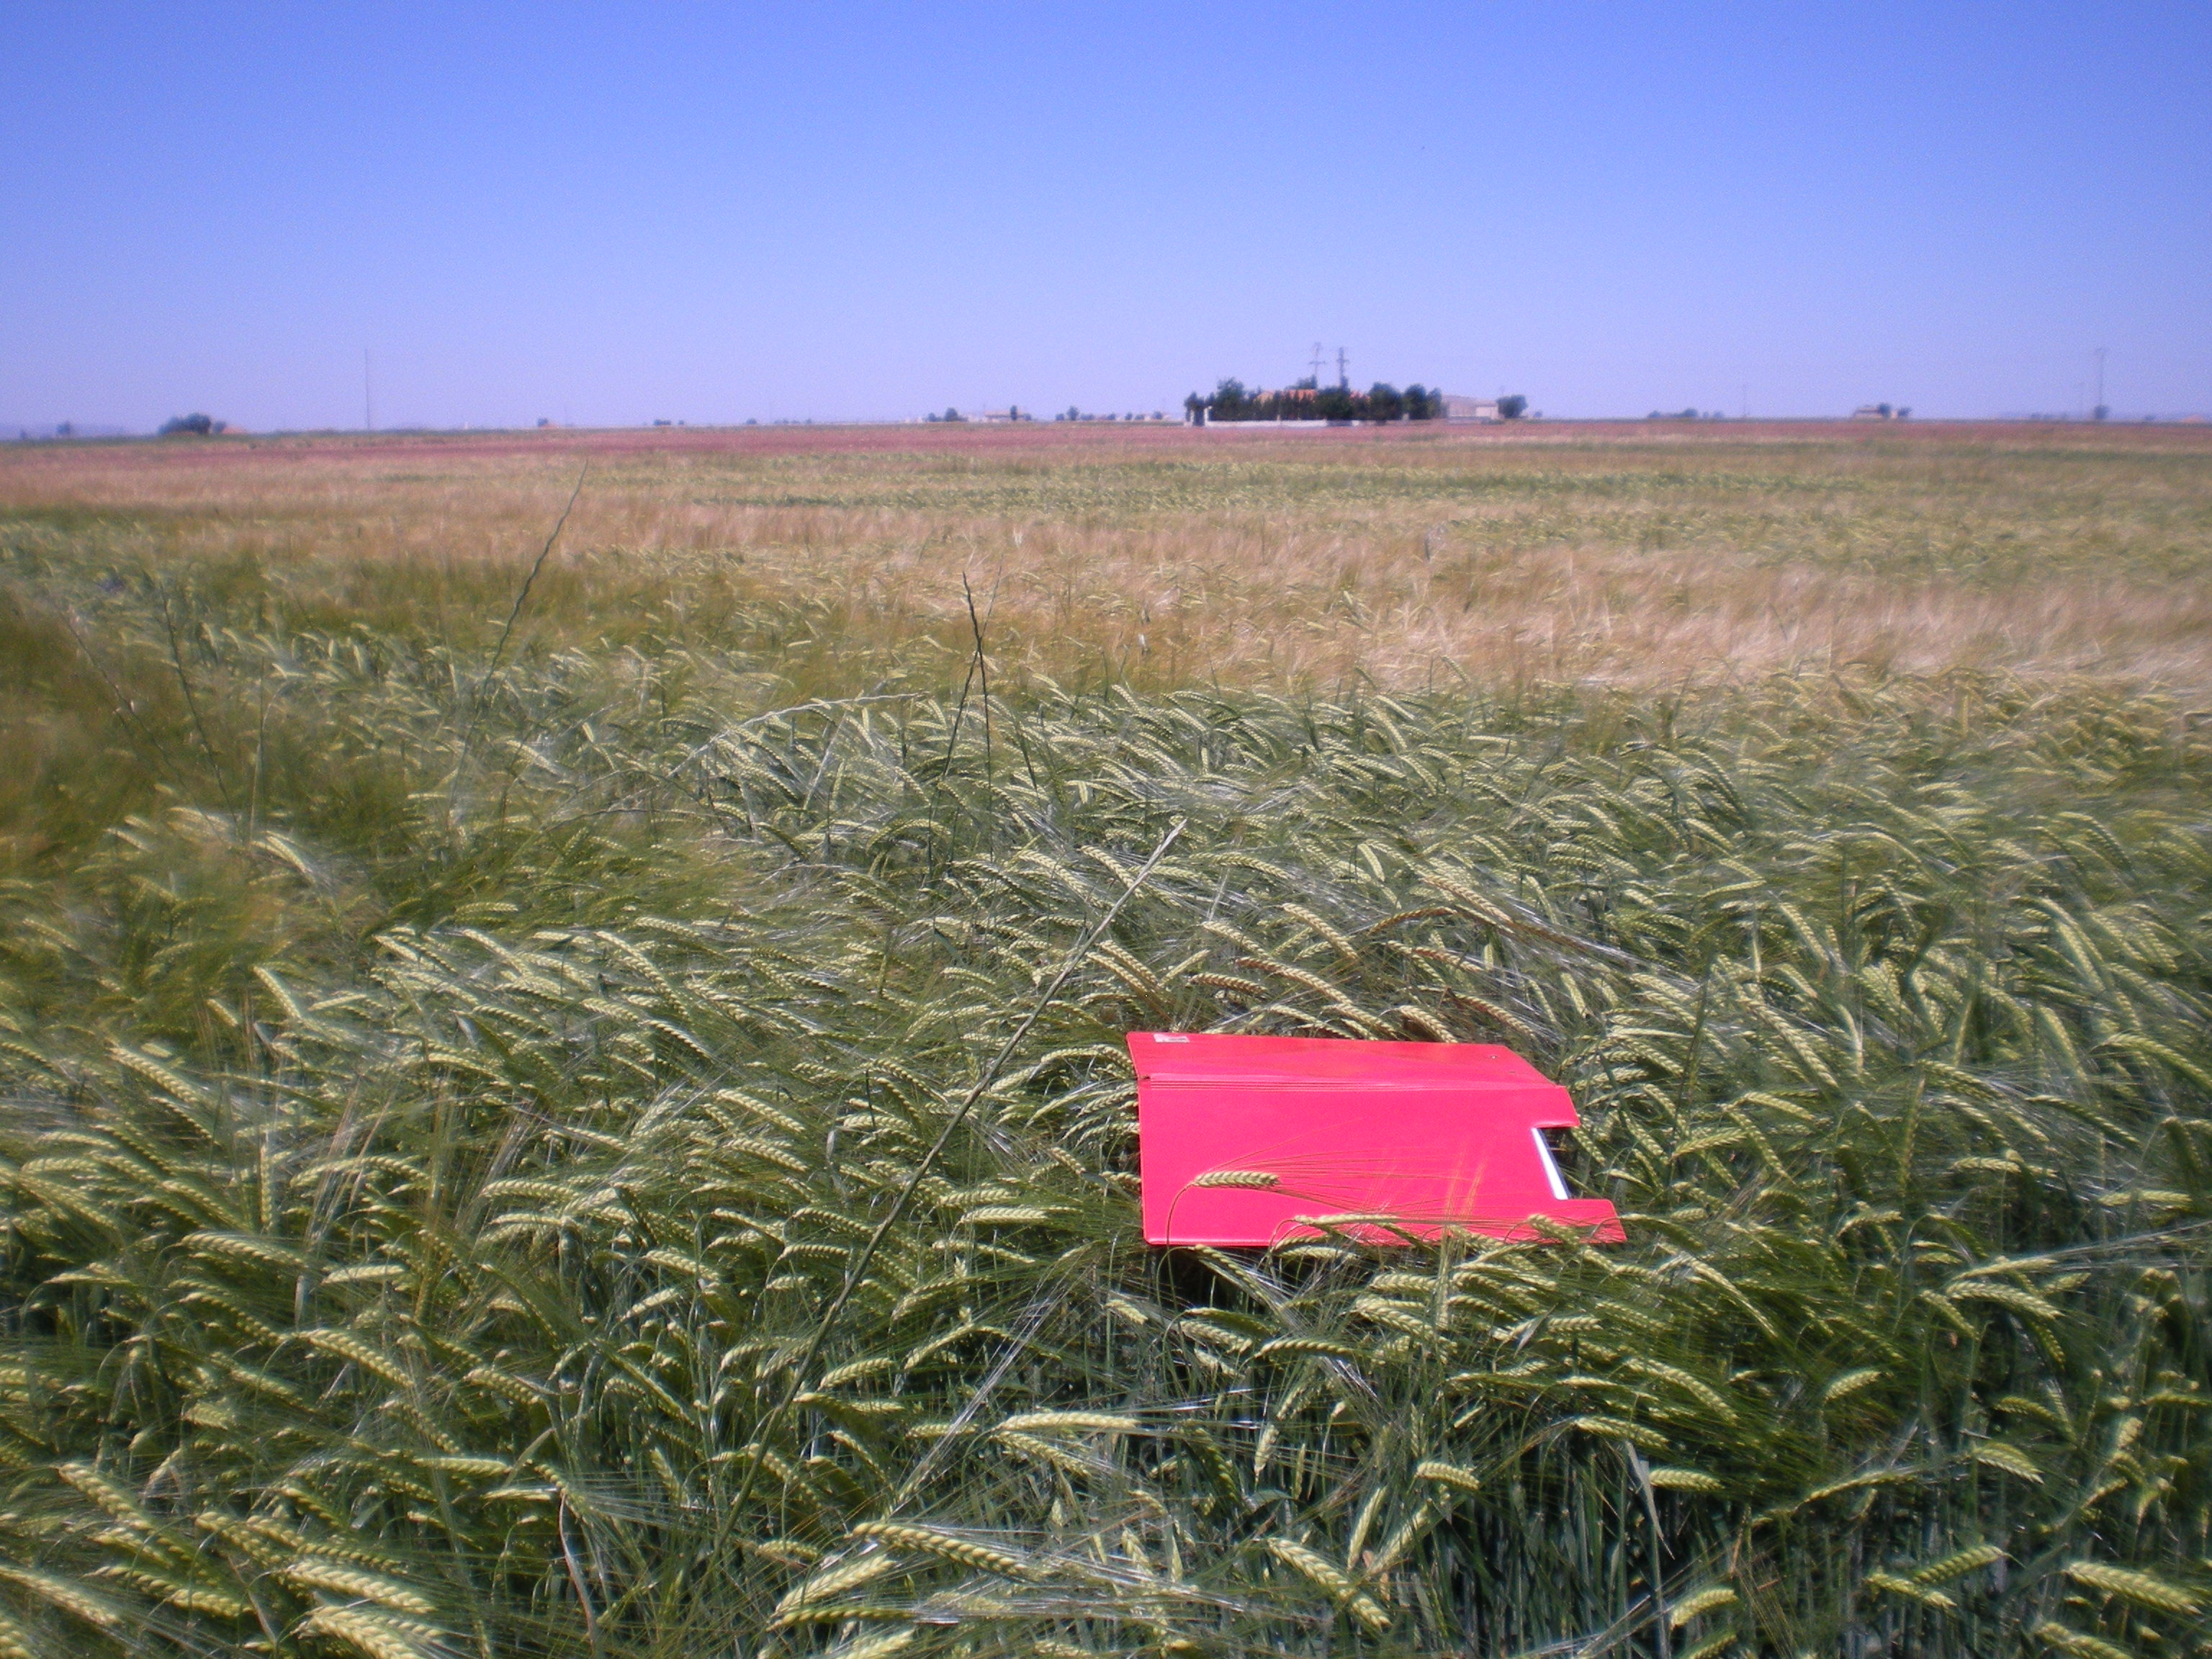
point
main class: Cropland
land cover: Barley
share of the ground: > 75 %
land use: Agriculture (excluding fallow land and kitchen gardens)
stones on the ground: 10 - 25 %
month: May
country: ES
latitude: 39.1437
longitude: -3.1225
